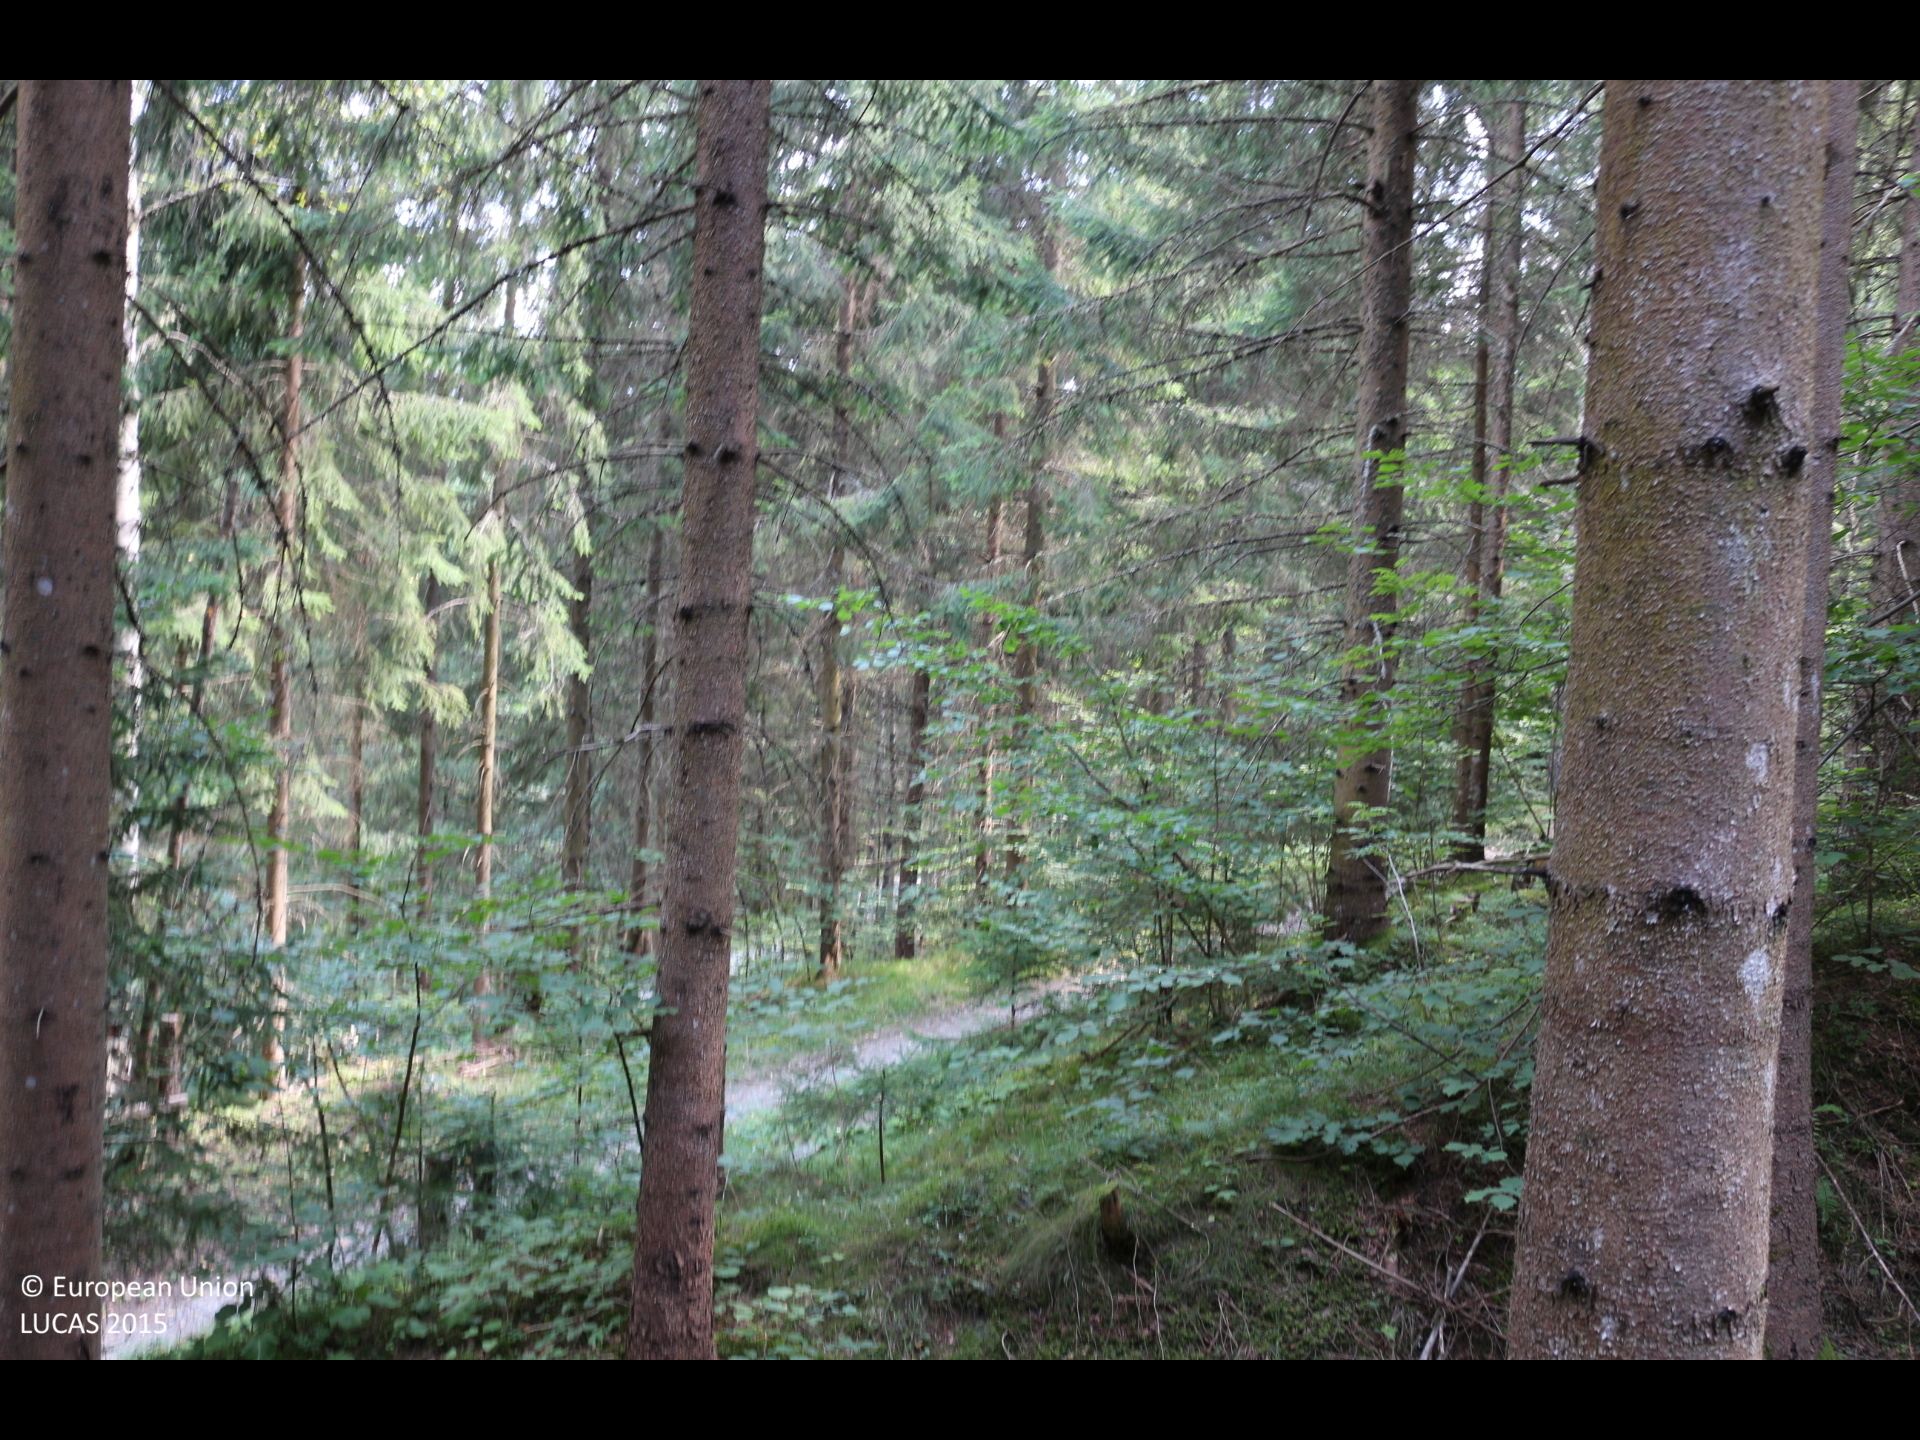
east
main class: Woodland
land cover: Spruce dominated coniferous woodland
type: alpine coniferous forest
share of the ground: > 75 %
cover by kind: coniferous forest trees 90 %, broadleaved forest trees 5 %, herbaceous plants 5 %
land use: Forestry
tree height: > 5 m
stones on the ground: 10 - 25 %
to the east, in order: Spruce dominated coniferous woodland; Tracks; Spruce dominated coniferous woodland; Tracks; Spruce dominated coniferous woodland; Tracks; Spruce dominated coniferous woodland; Spruce dominated mixed woodland
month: August
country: AT
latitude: 46.8855
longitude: 14.1053
